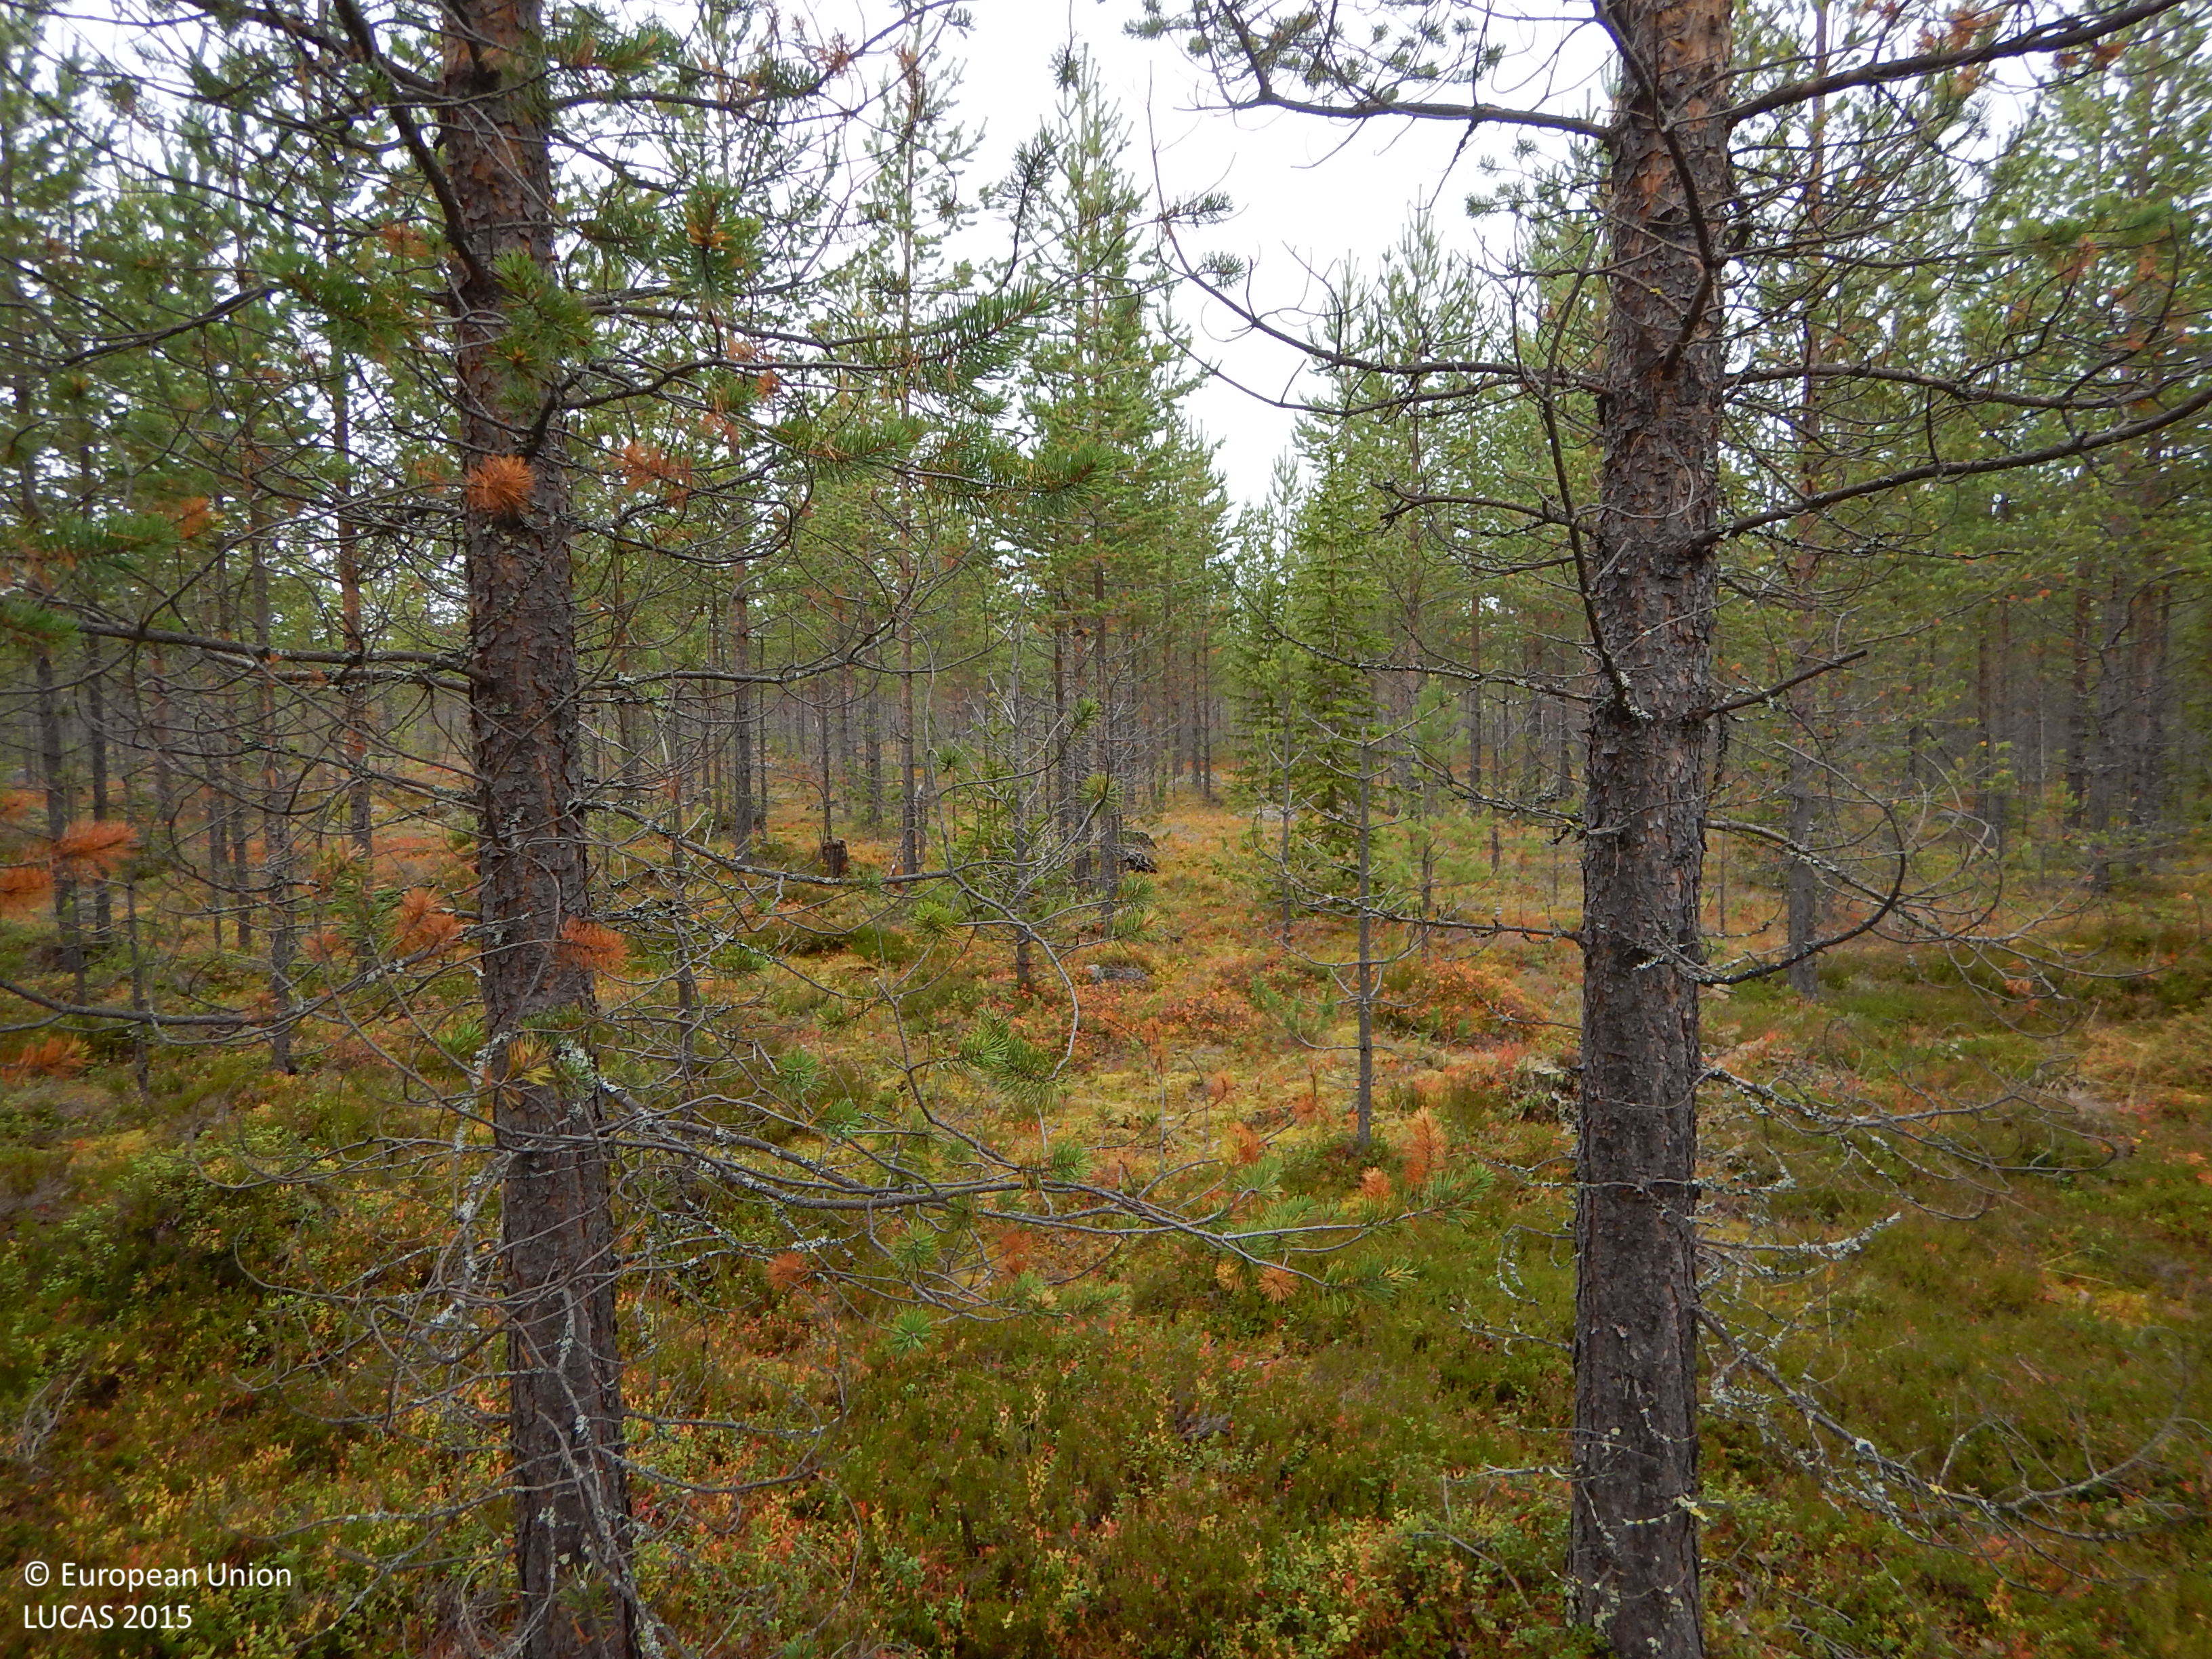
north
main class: Woodland
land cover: Pine dominated coniferous woodland
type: boreal forest
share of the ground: 25 - 50 %
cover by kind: shrubs 40 %, coniferous forest trees 35 %, lichens and mosses 15 %, herbaceous plants 10 %
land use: Forestry
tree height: < 5 m
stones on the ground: < 10 %
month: September
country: SE
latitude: 65.1708
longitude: 19.1632
